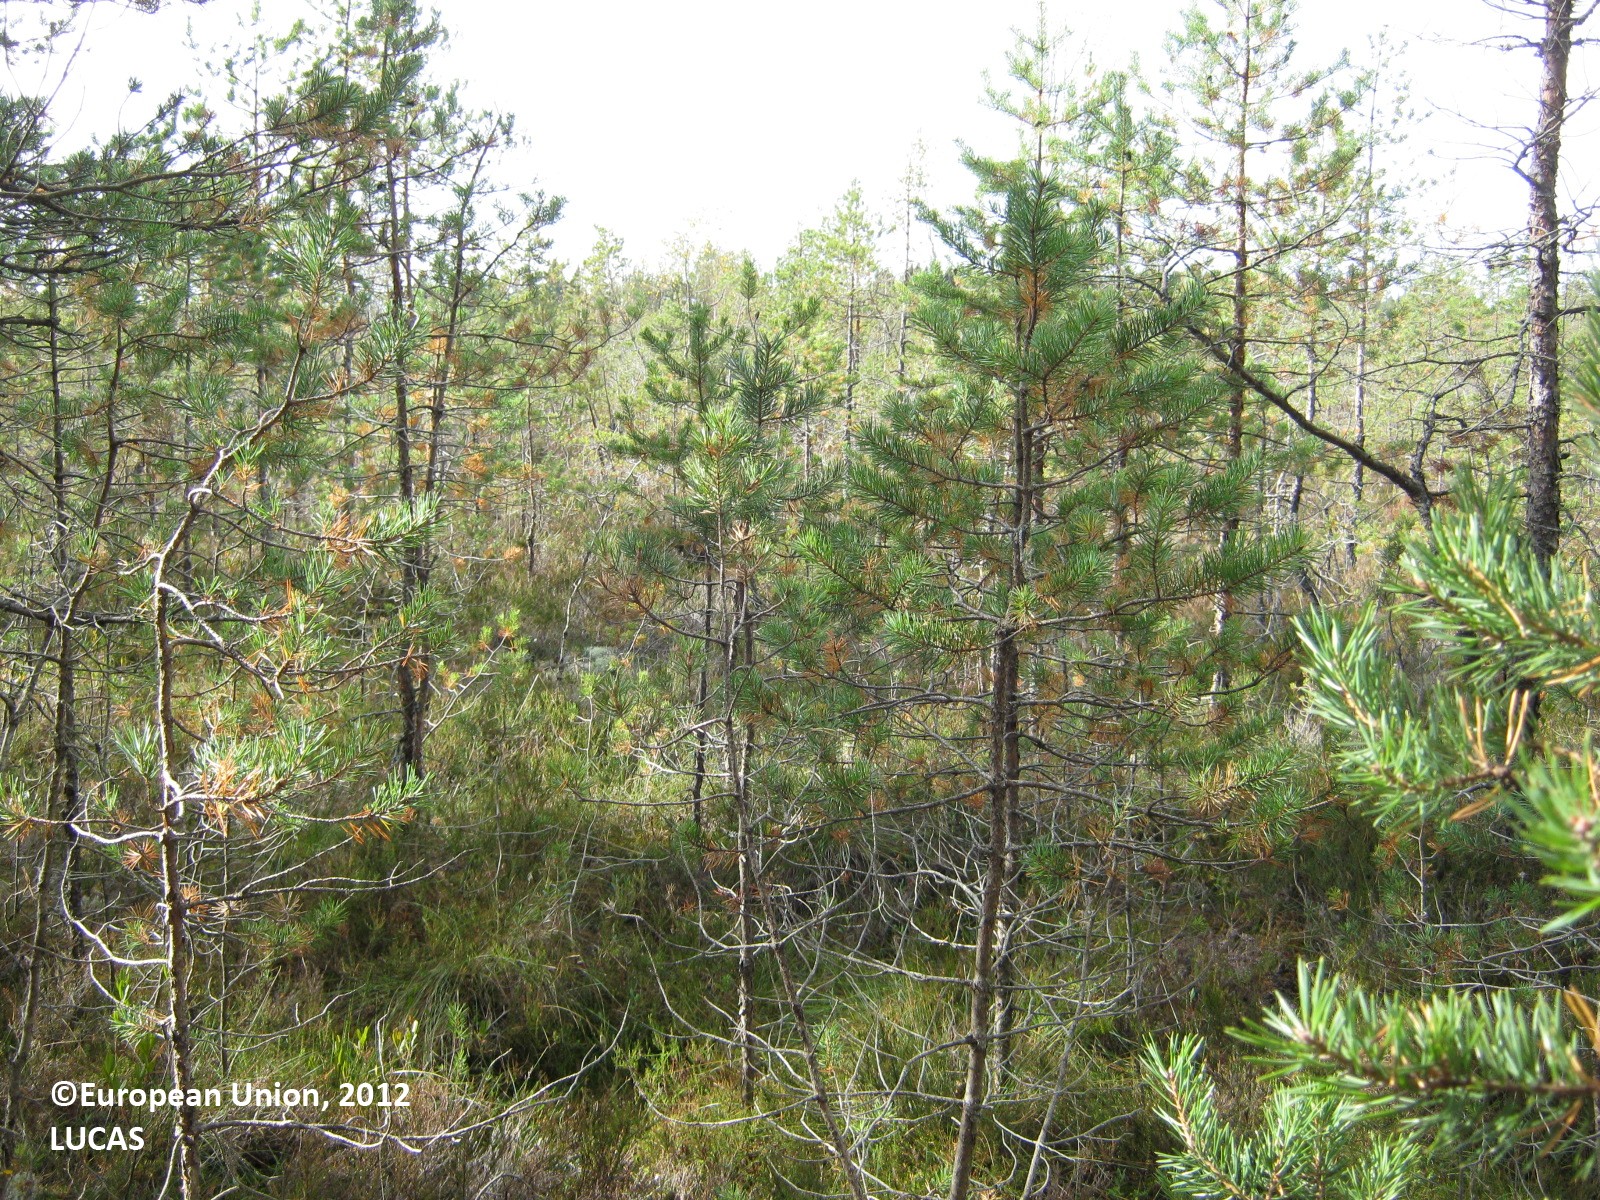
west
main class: Woodland
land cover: Pine dominated coniferous woodland
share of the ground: 50 - 75 %
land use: Forestry
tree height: < 5 m
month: September
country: FI
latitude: 60.9818
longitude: 28.2253
